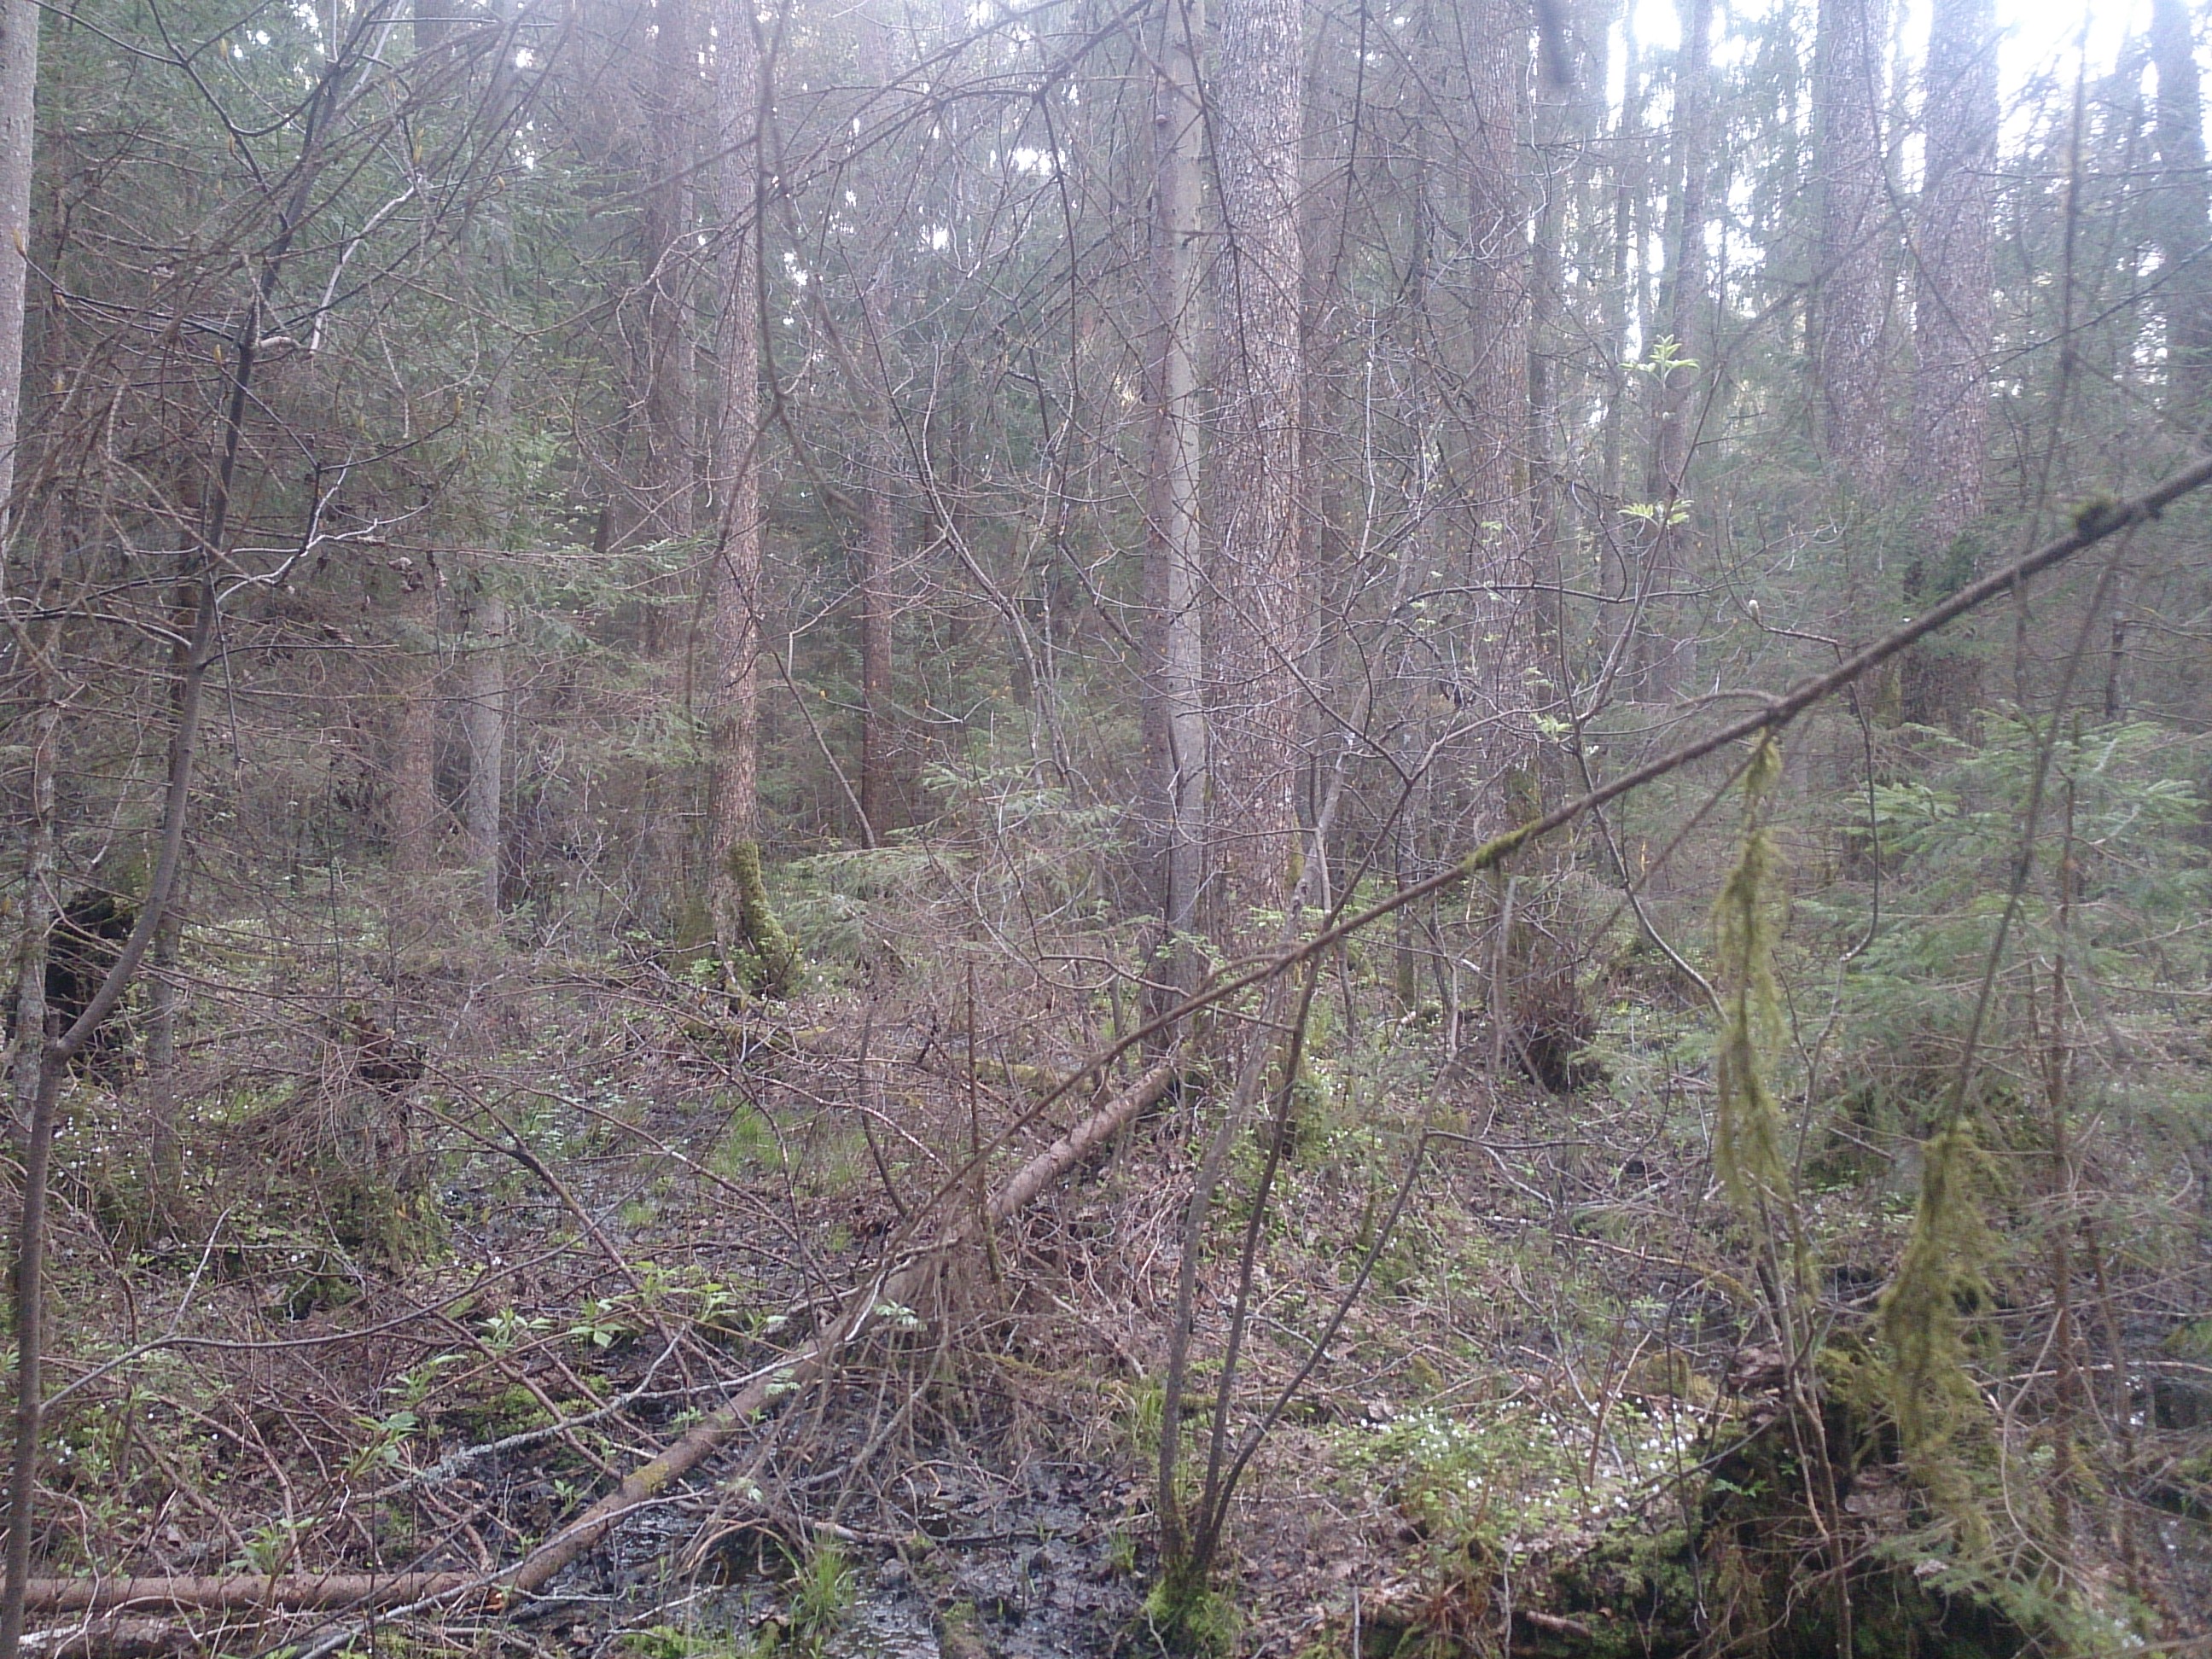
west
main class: Woodland
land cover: Spruce dominated mixed woodland
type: hemiboreal forest and nemoral coniferous forest and mixed broadleaved-coniferous forest
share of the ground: > 75 %
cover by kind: coniferous forest trees 50 %, broadleaved forest trees 50 %
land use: Forestry
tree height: > 5 m
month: May
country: LV
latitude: 56.7182
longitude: 24.1222
